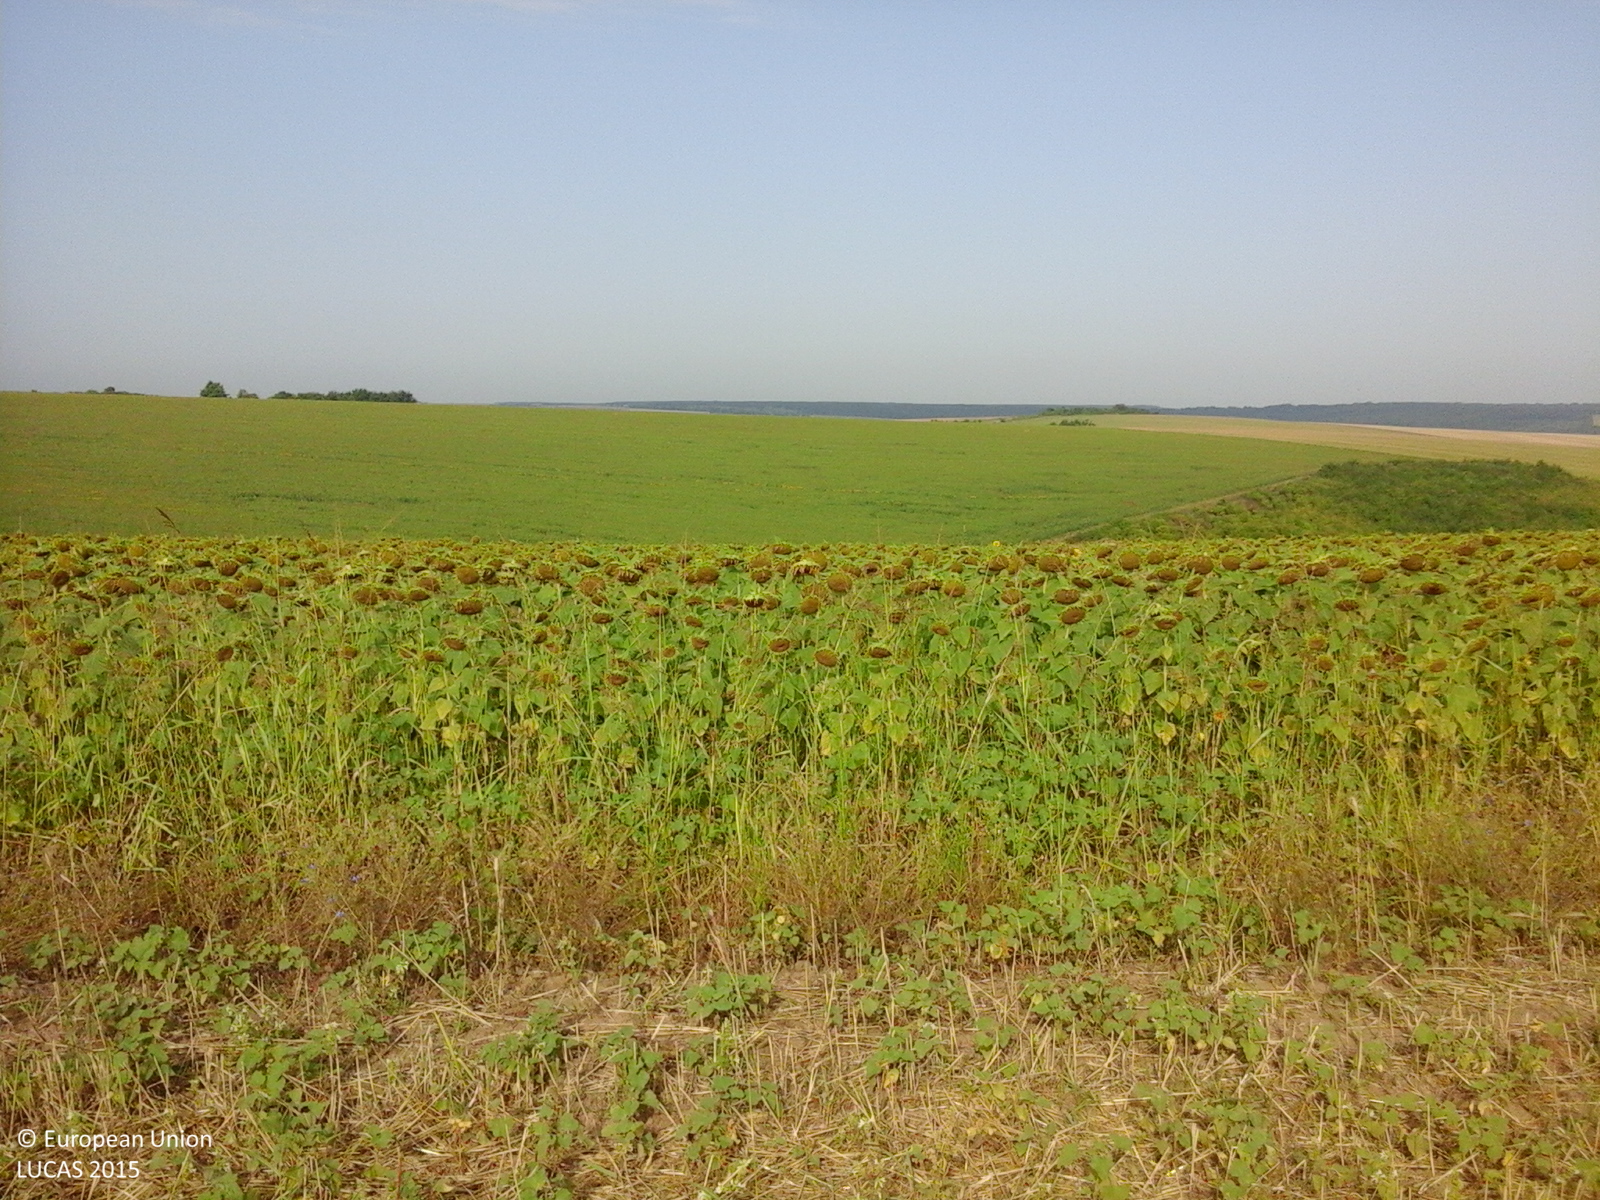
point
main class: Cropland
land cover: Sunflower
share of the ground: > 75 %
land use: Agriculture (excluding fallow land and kitchen gardens)
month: August
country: RO
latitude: 44.0350
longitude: 27.6745
